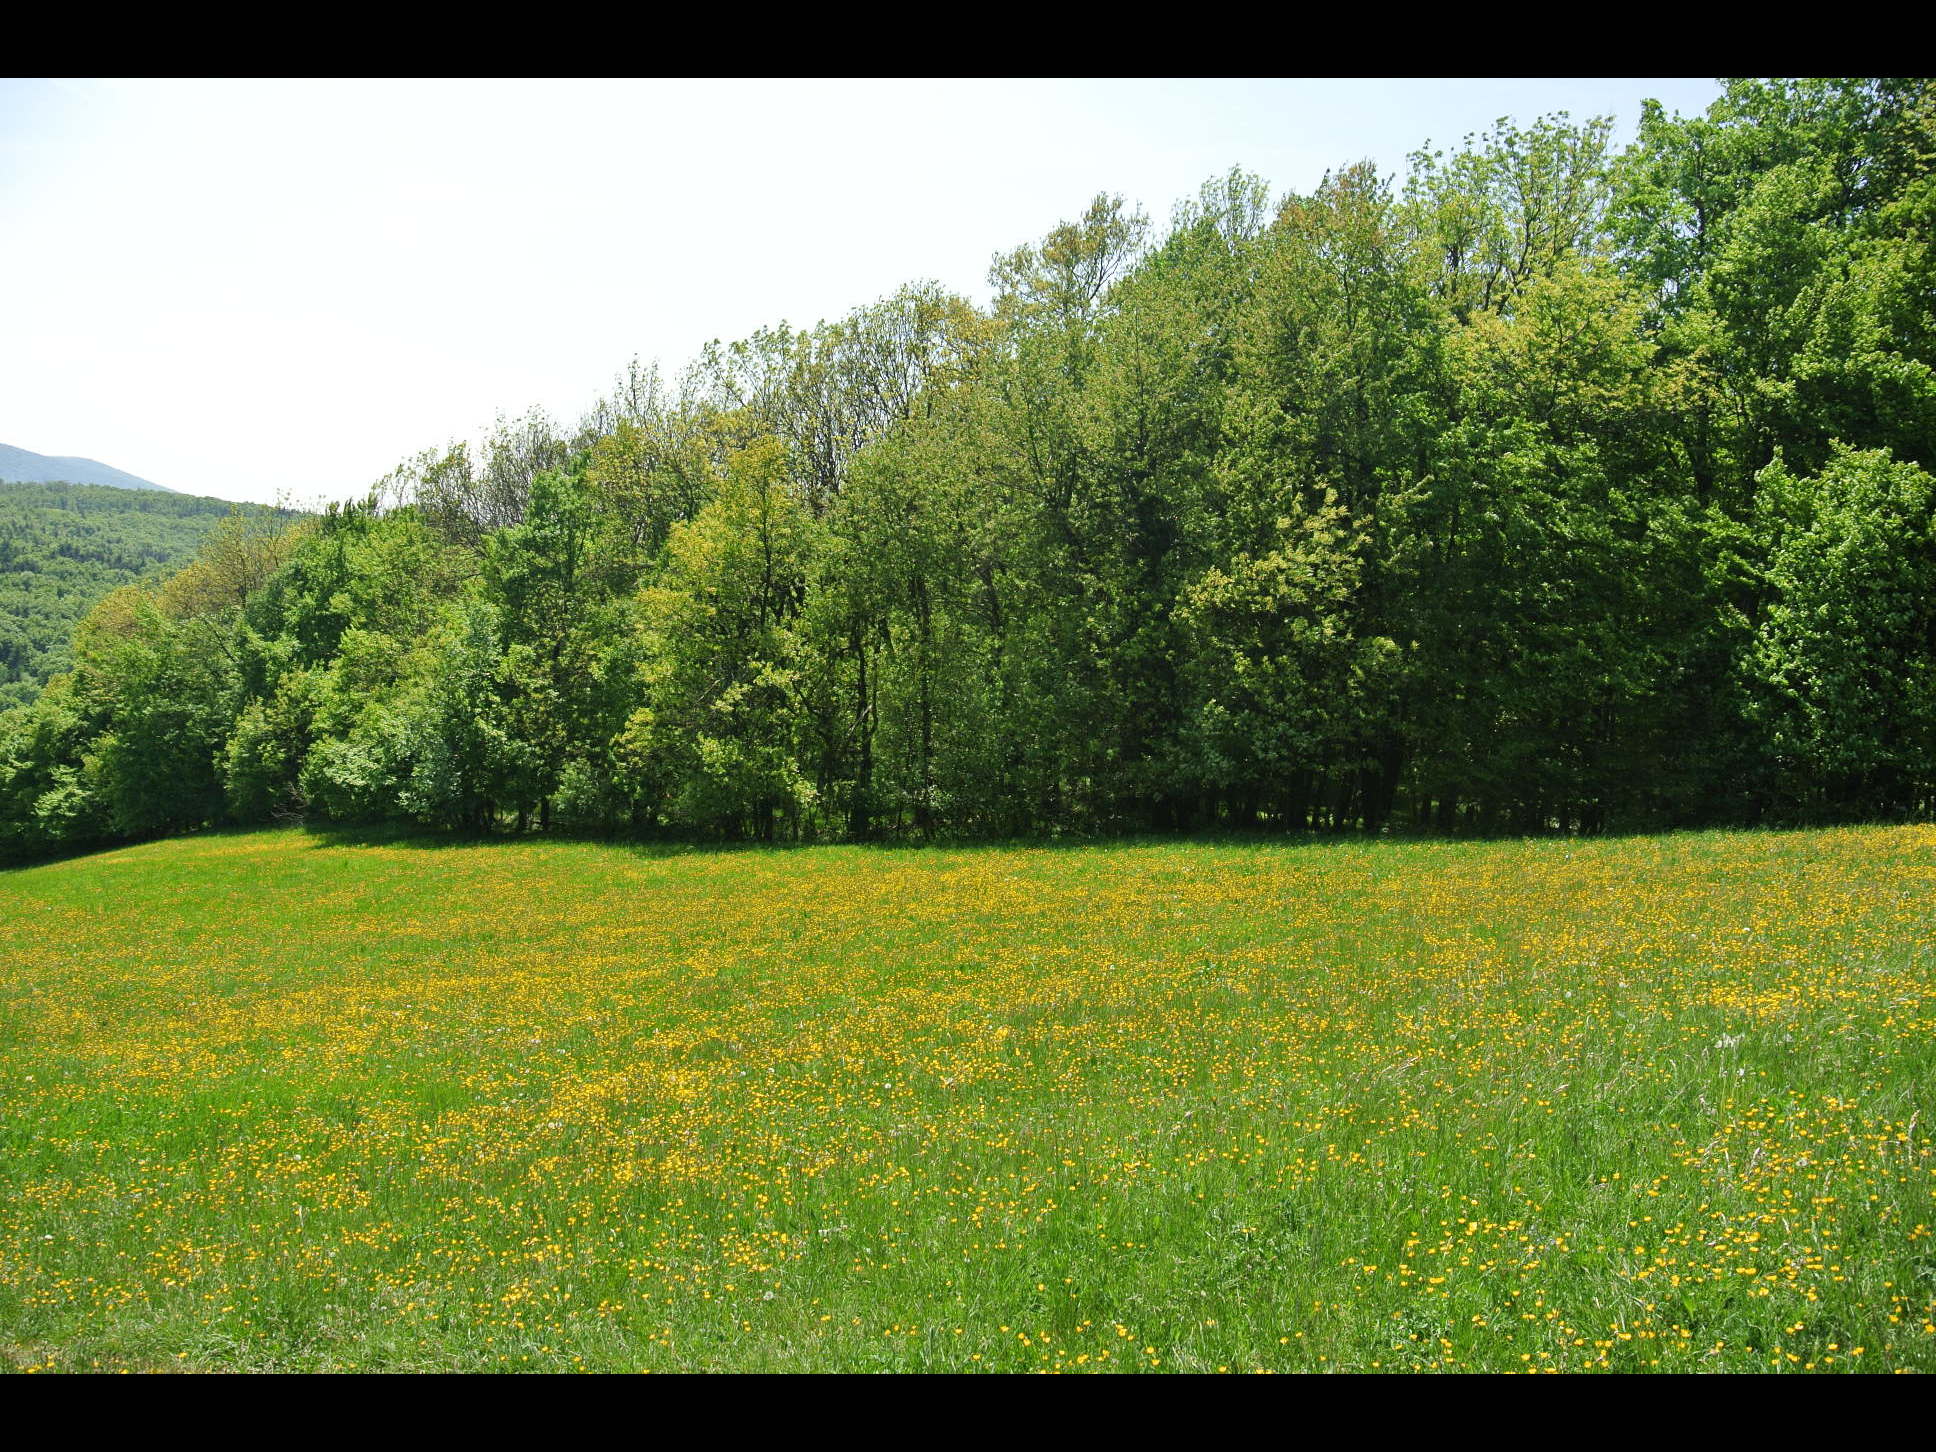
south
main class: Grassland
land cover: Grassland without tree/shrub cover
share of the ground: > 75 %
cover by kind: herbaceous plants 100 %
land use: Agriculture (excluding fallow land and kitchen gardens)
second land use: Amenities, museums, leisure
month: May
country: AT
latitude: 48.1019
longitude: 16.2219
